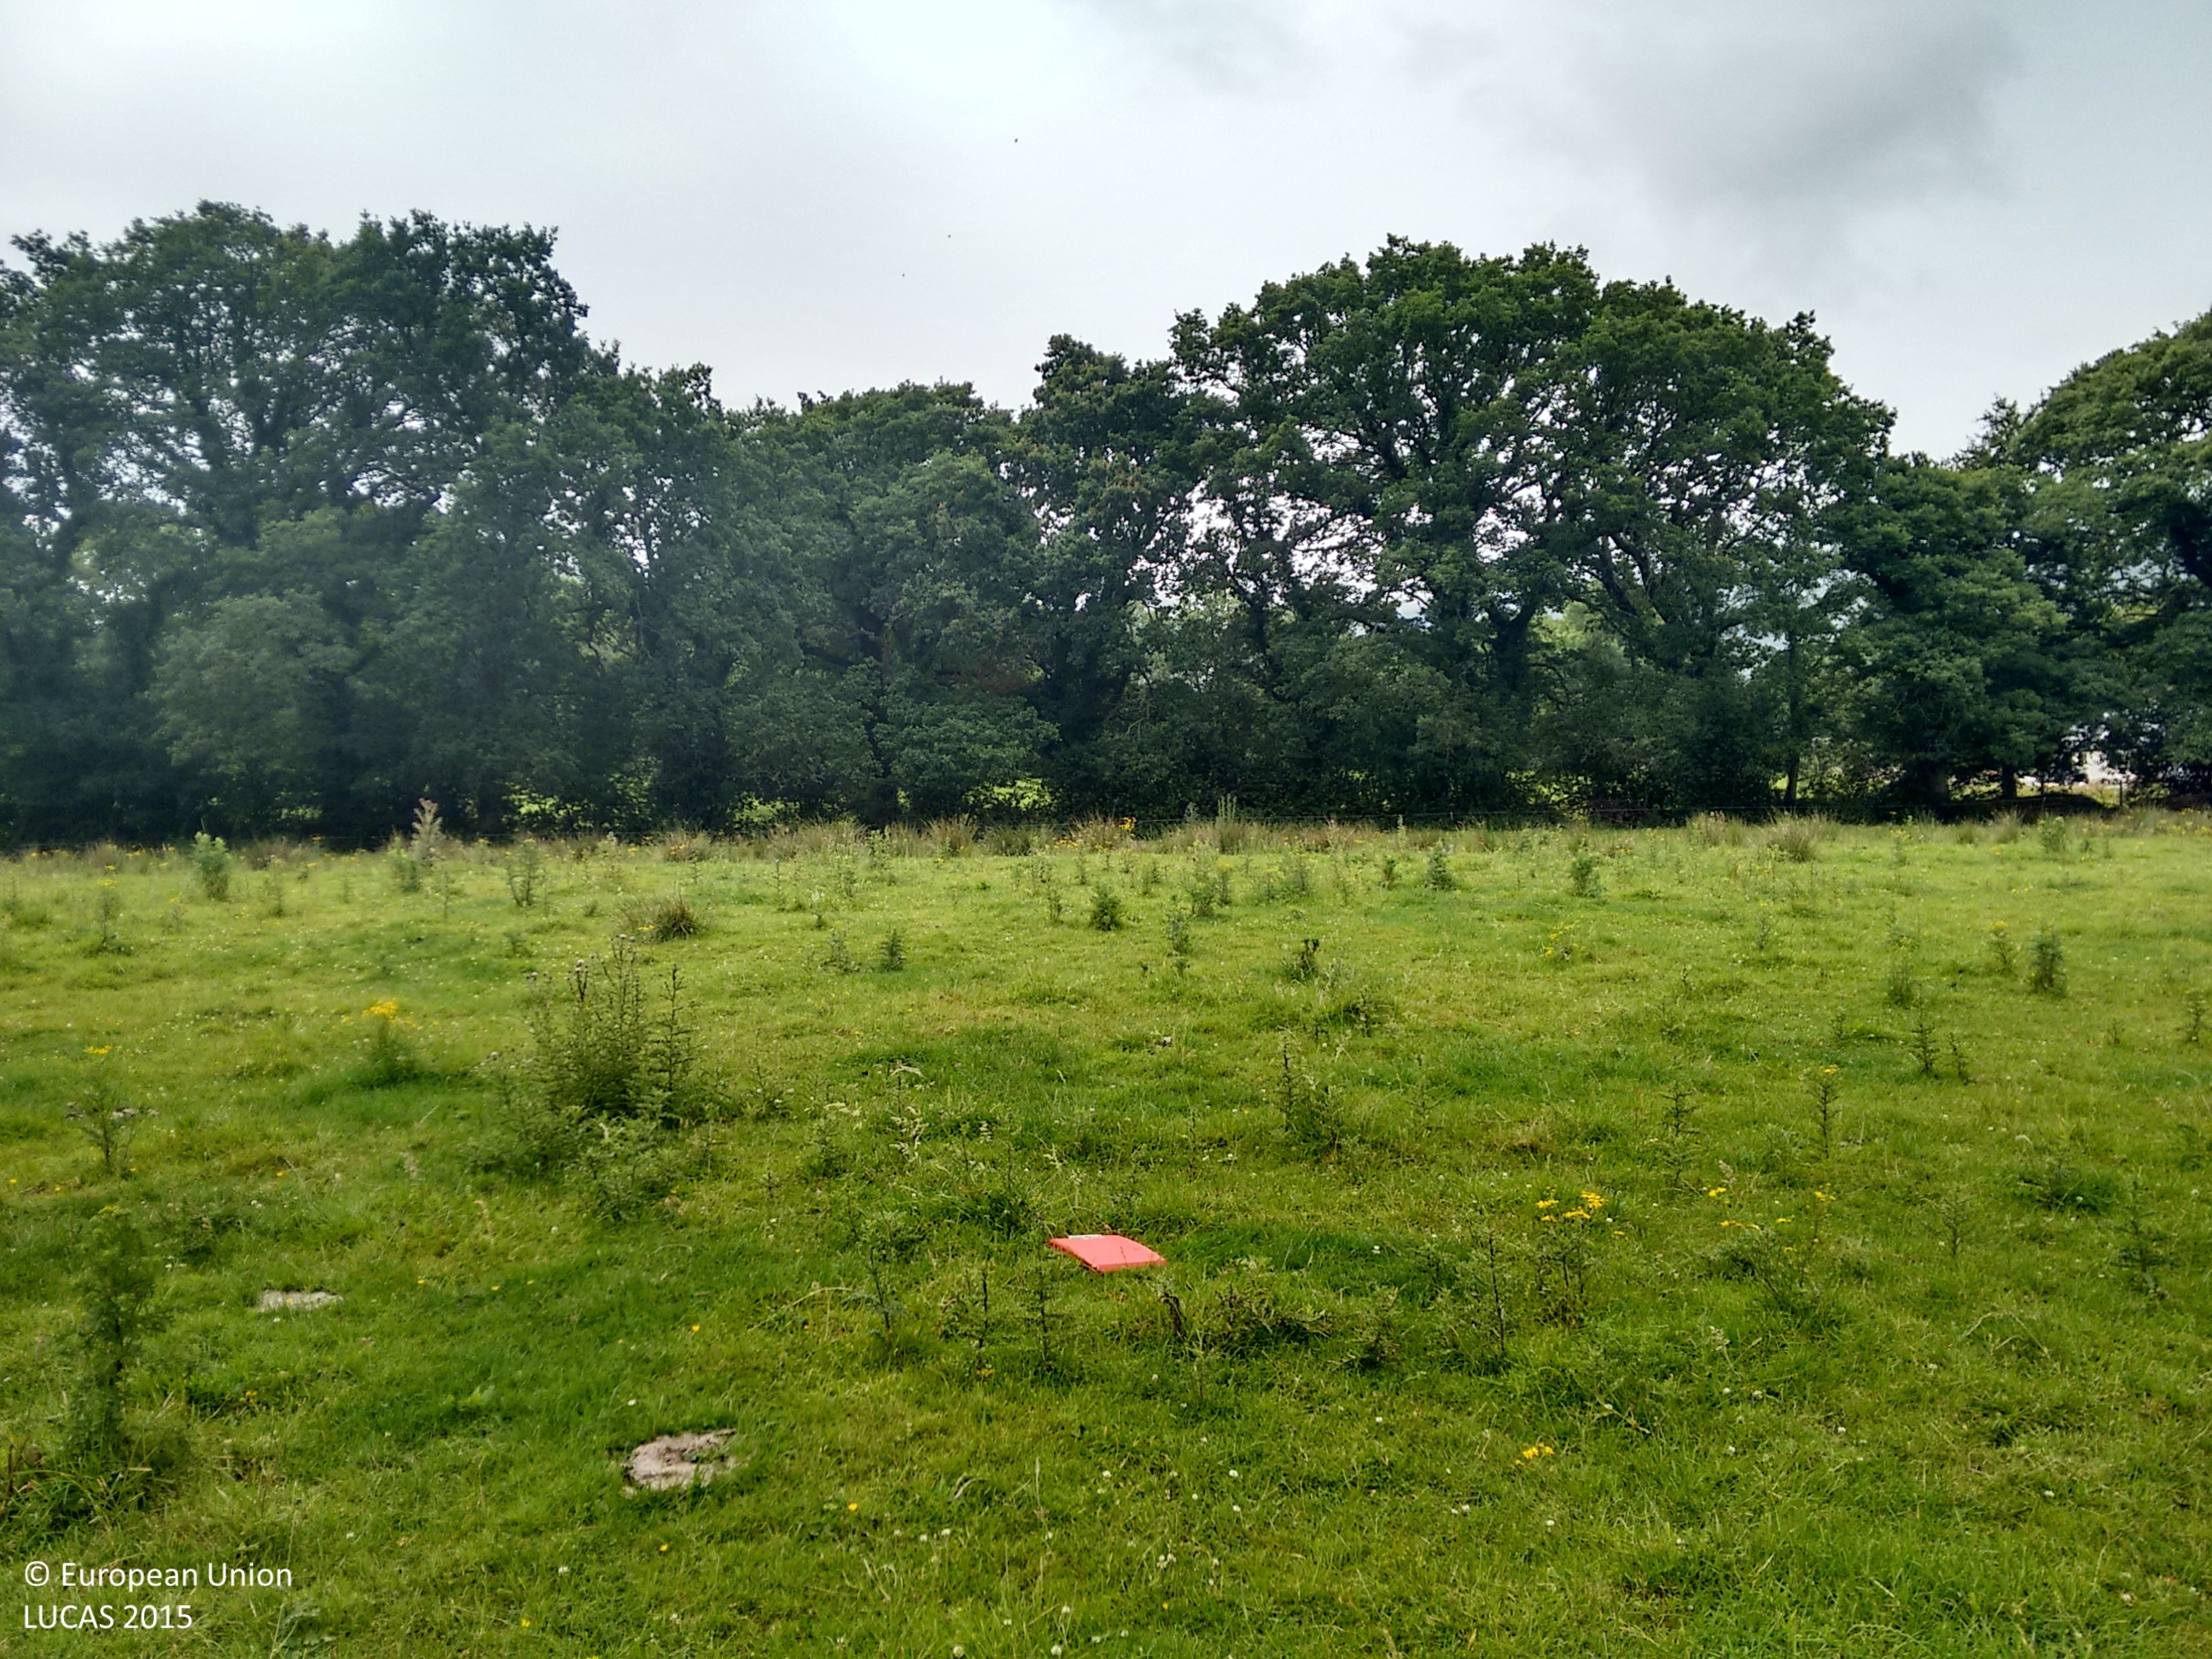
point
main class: Grassland
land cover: Grassland without tree/shrub cover
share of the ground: > 75 %
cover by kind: herbaceous plants 100 %
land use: Agriculture (excluding fallow land and kitchen gardens)
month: July
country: IE
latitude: 52.4123
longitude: -8.1922
